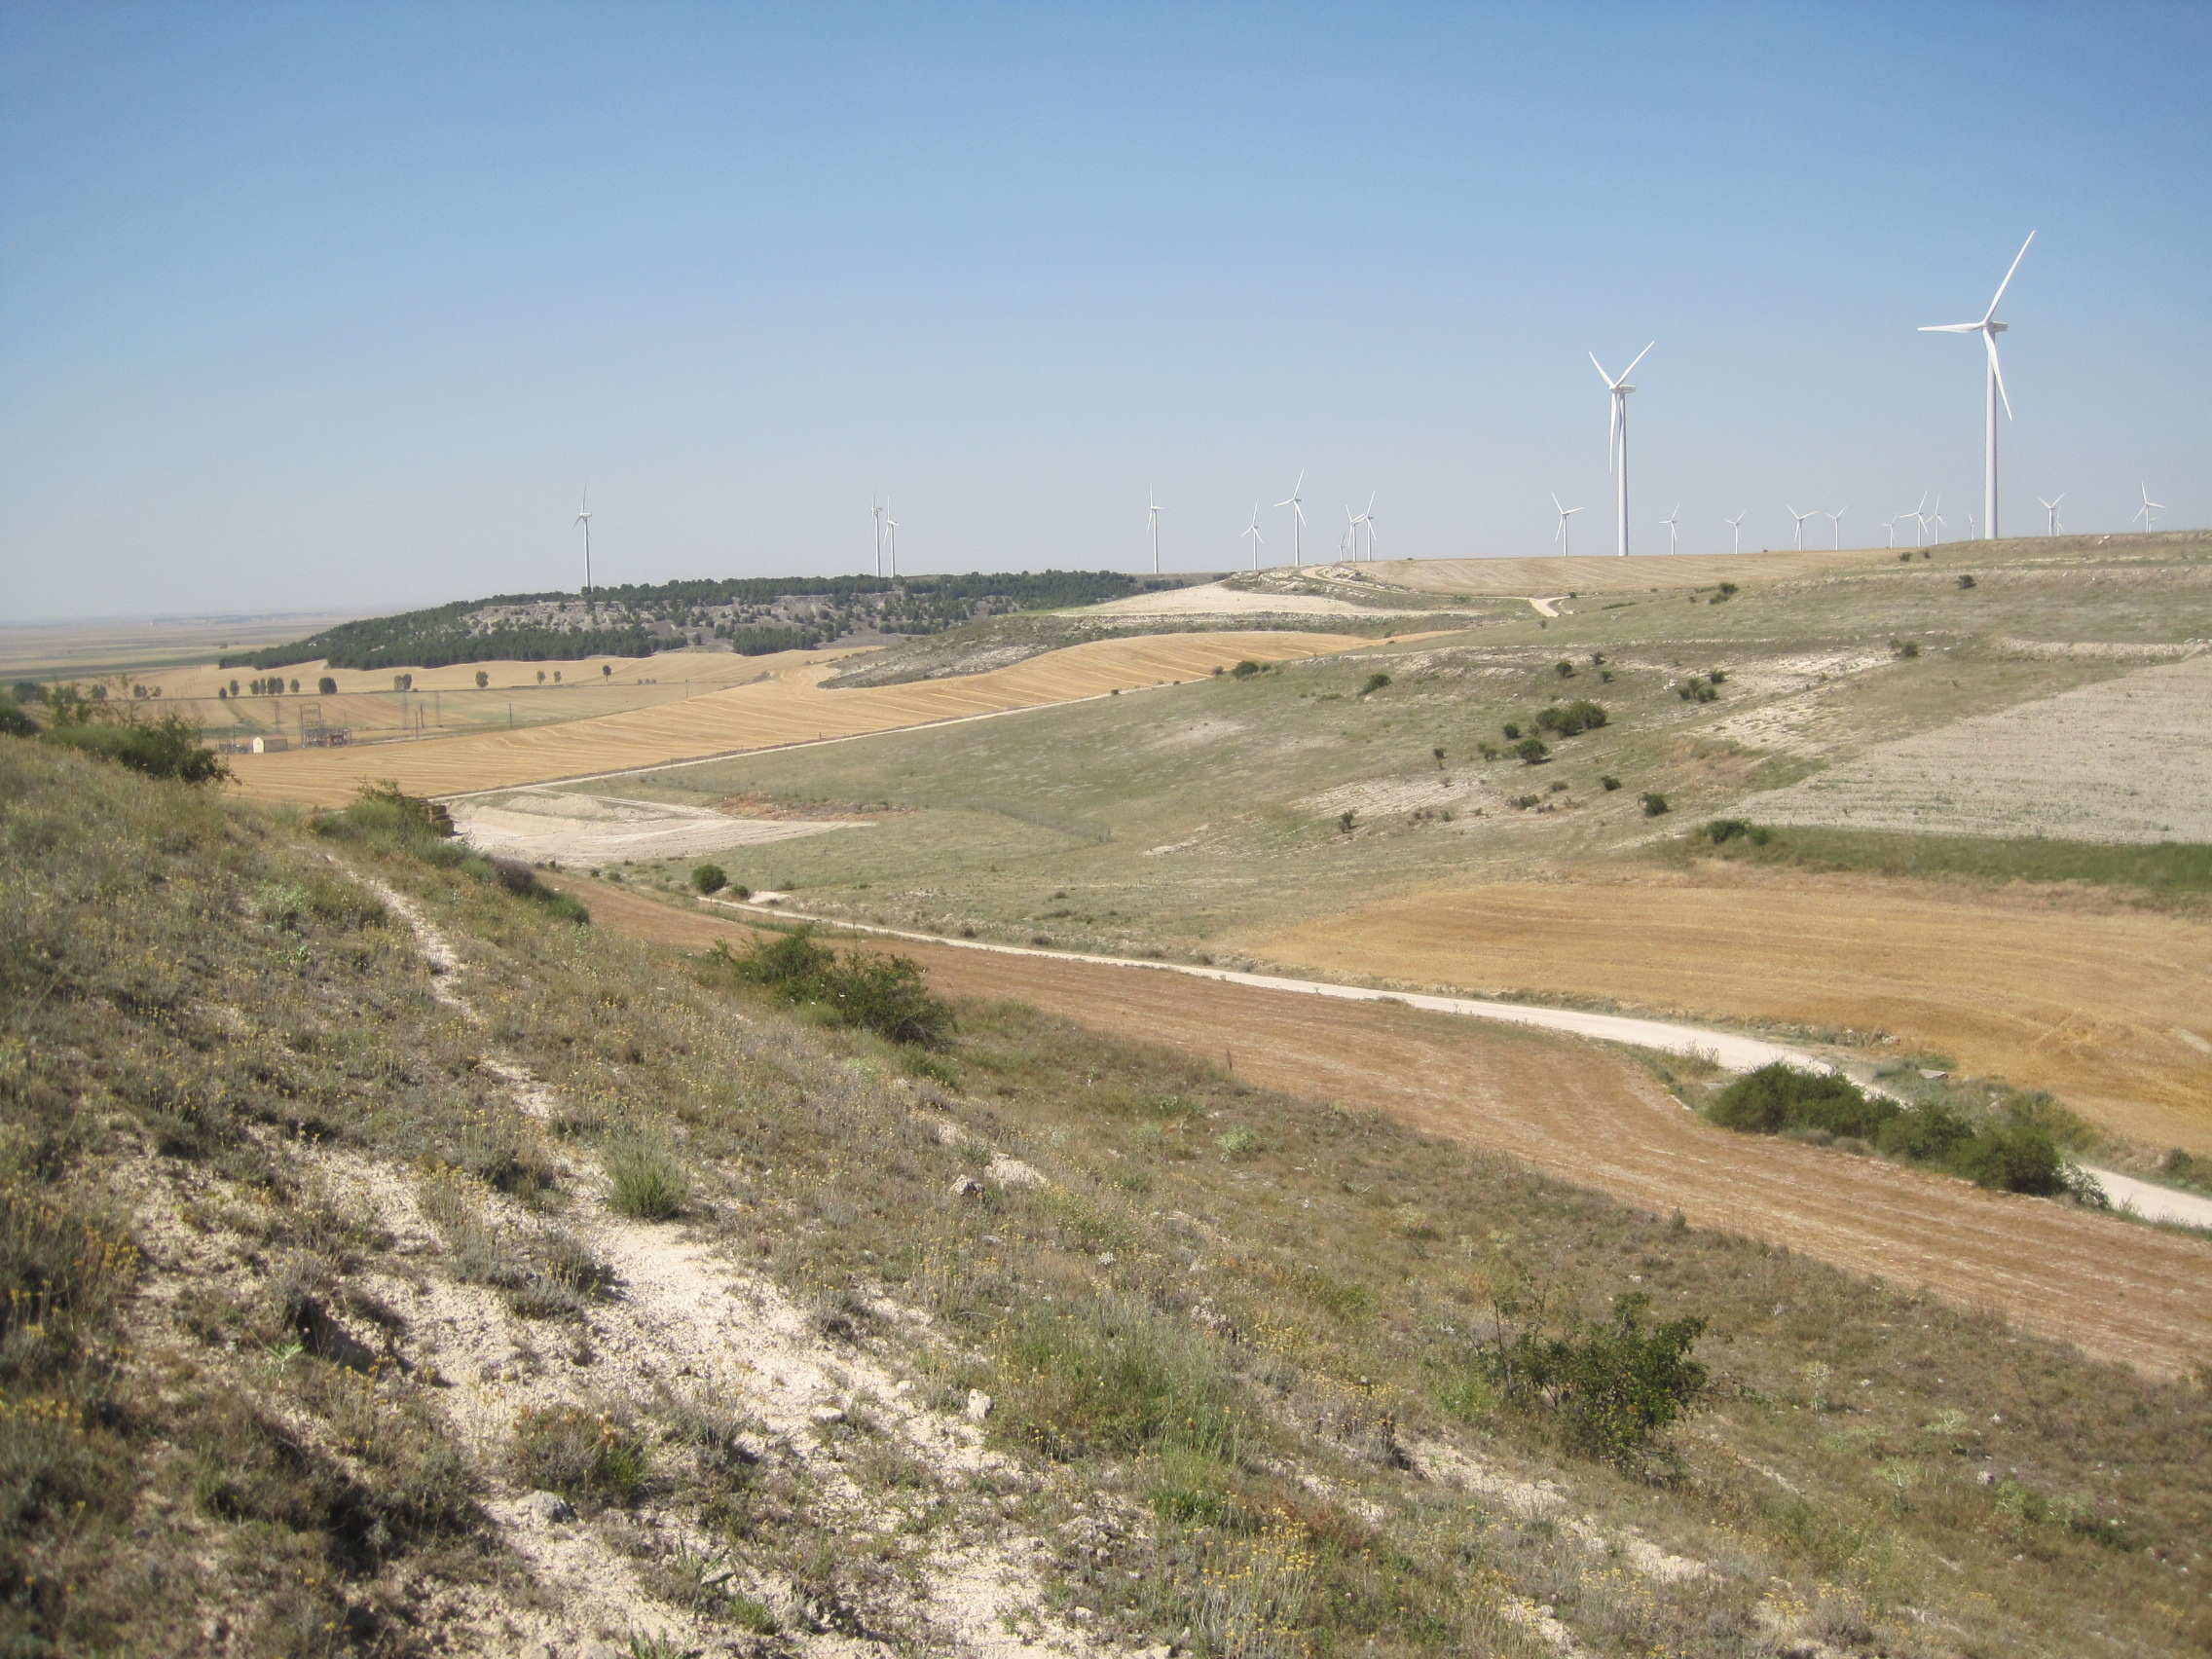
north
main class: Grassland
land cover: Grassland without tree/shrub cover
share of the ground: > 75 %
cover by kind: herbaceous plants 95 %, shrubs 5 %
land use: Semi-natural and natural areas not in use
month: July
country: ES
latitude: 41.9126
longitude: -4.7698
